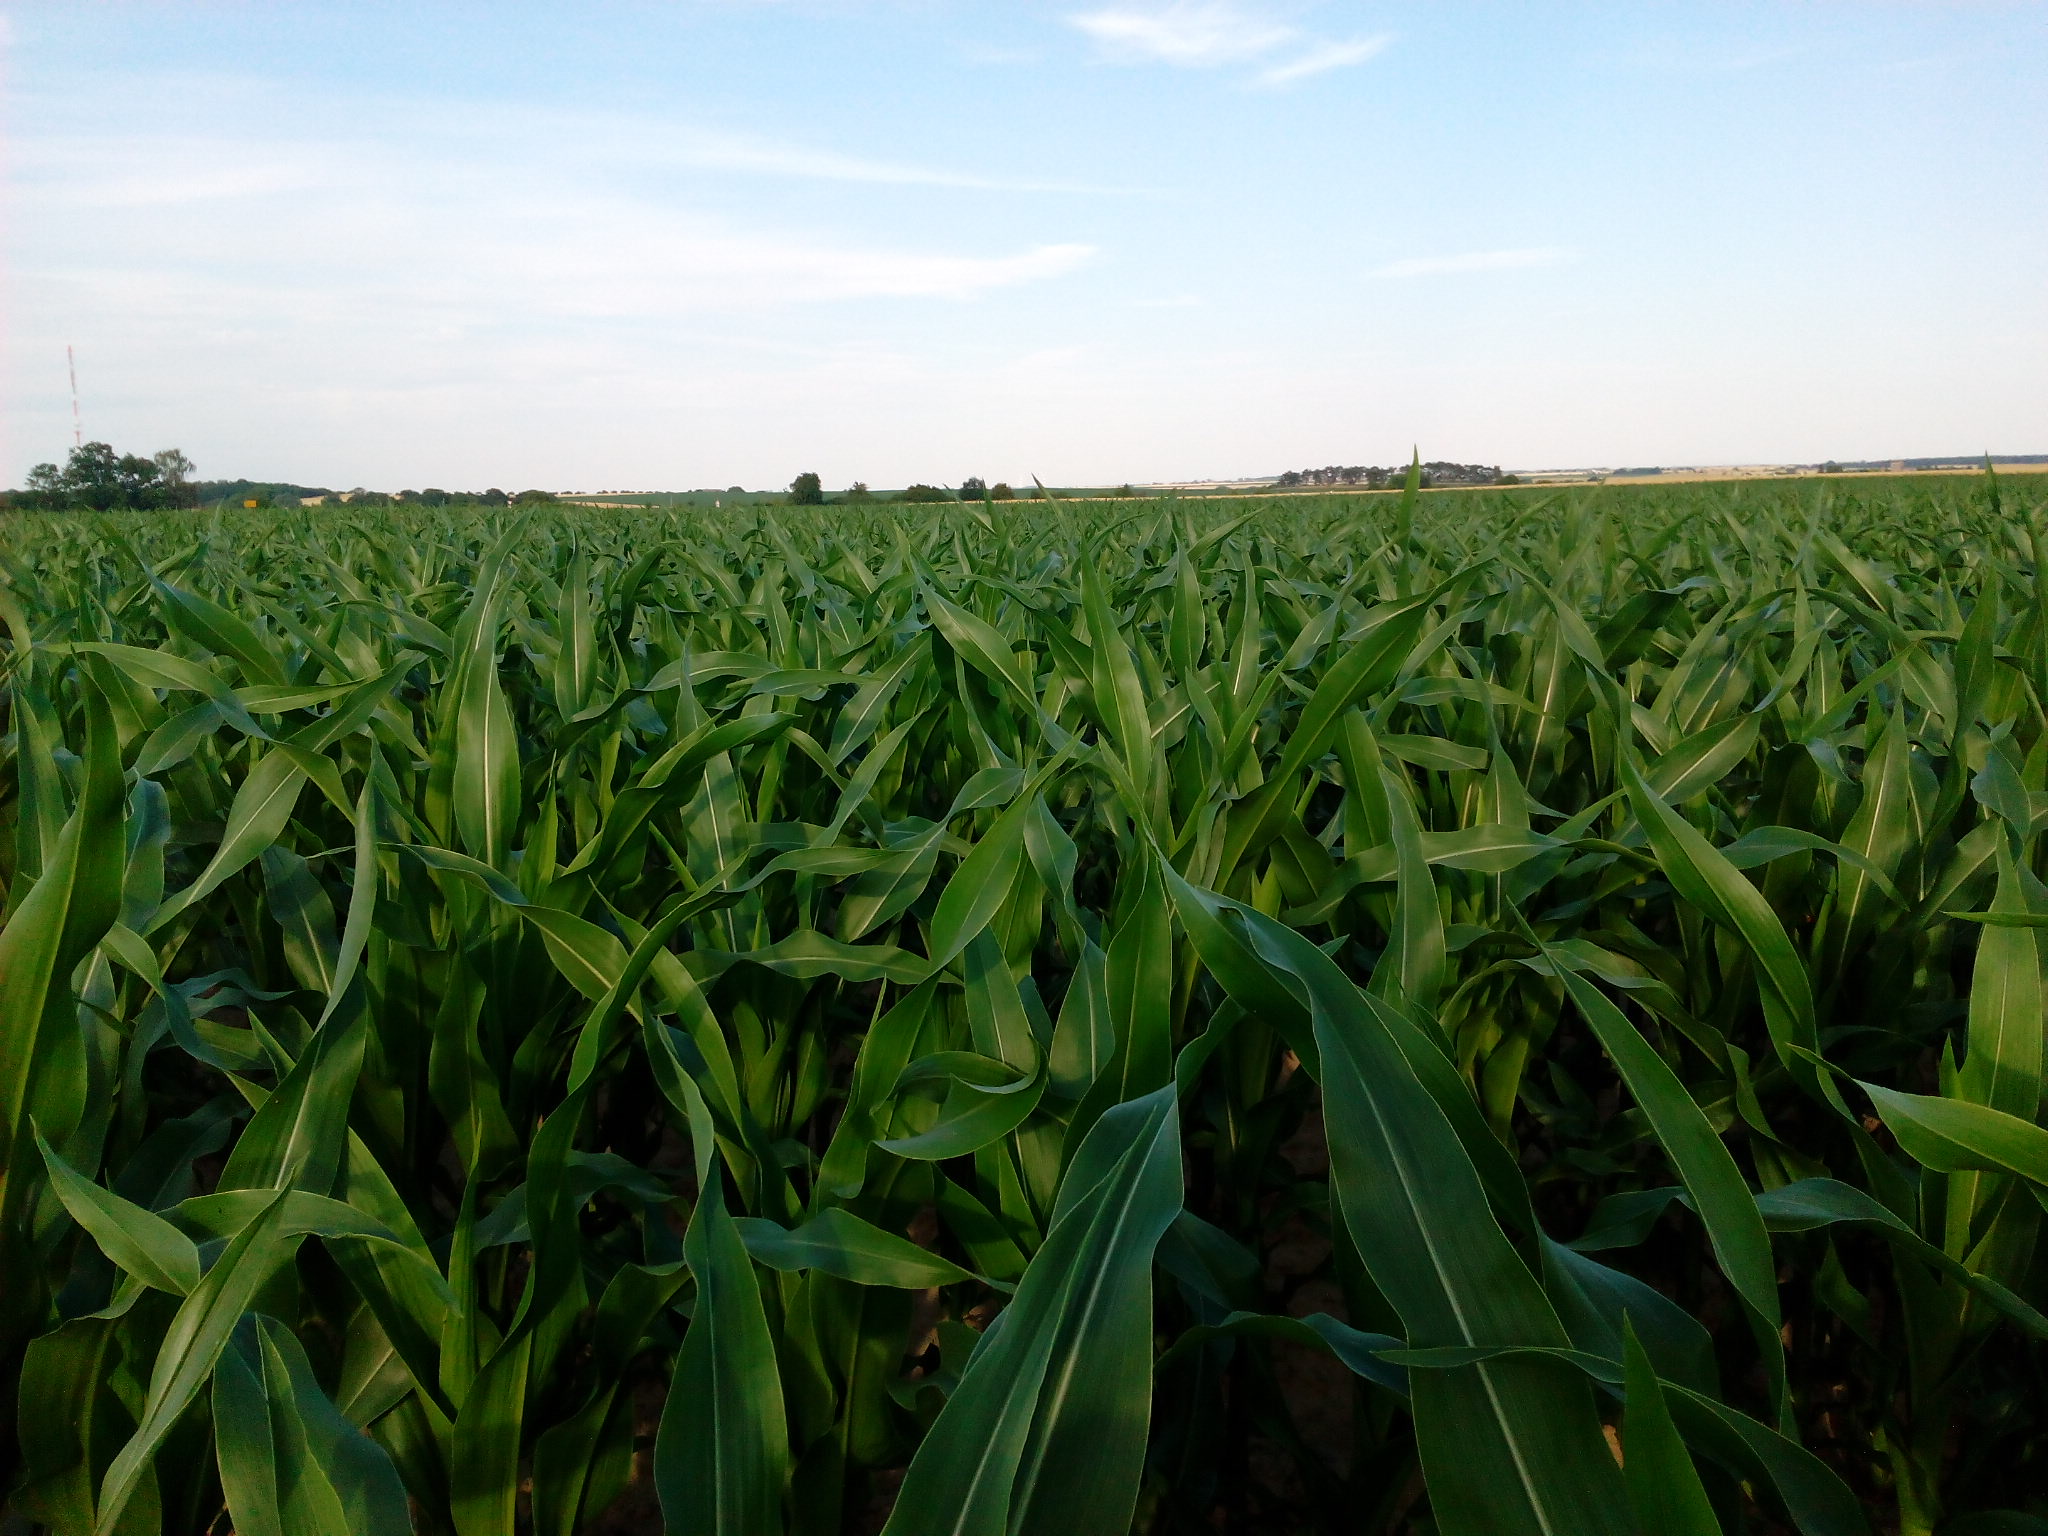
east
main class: Cropland
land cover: Maize
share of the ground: 50 - 75 %
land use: Agriculture (excluding fallow land and kitchen gardens)
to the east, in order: Maize; Grass margins; Paved roads, cycling and walking lanes; Grass margins; Common wheat
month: July
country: DE
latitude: 53.2219
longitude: 14.1794
